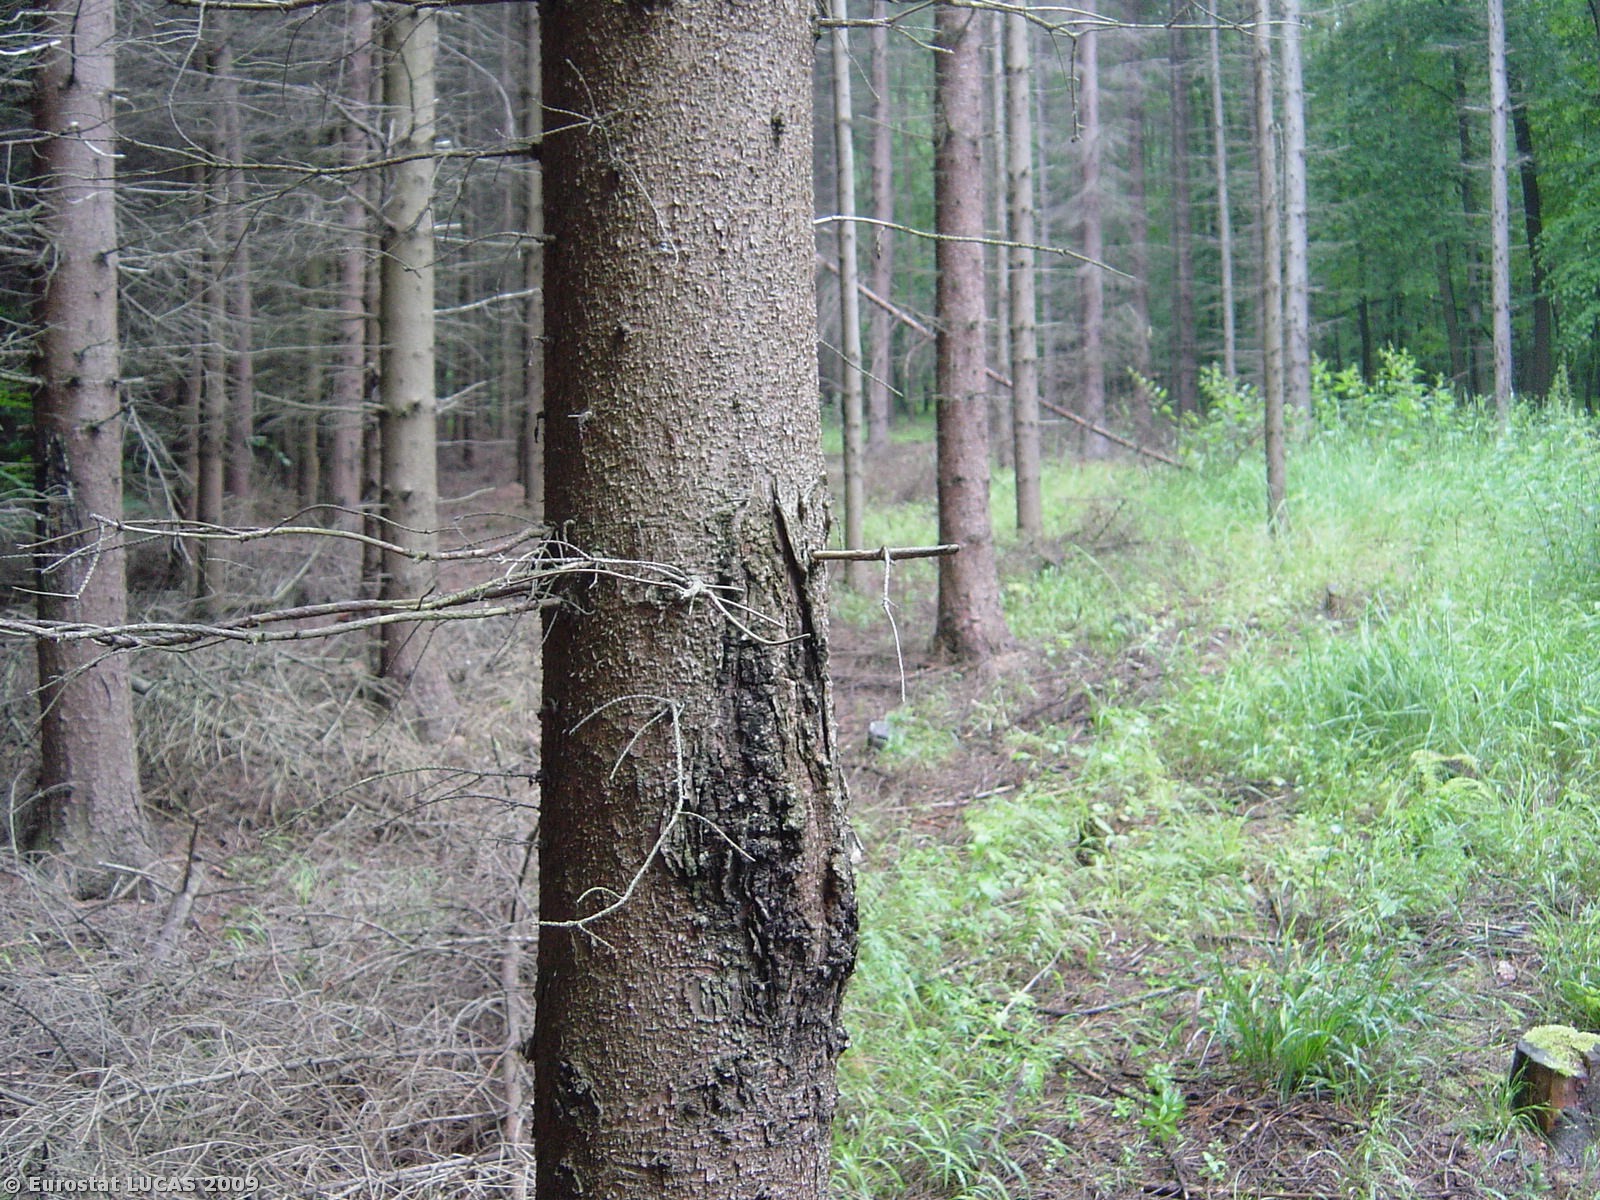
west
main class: Woodland
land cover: Coniferous woodland
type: hemiboreal forest and nemoral coniferous forest and mixed broadleaved-coniferous forest
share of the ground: > 75 %
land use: Forestry
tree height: > 5 m
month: June
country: CZ
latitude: 49.2382
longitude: 17.1381
